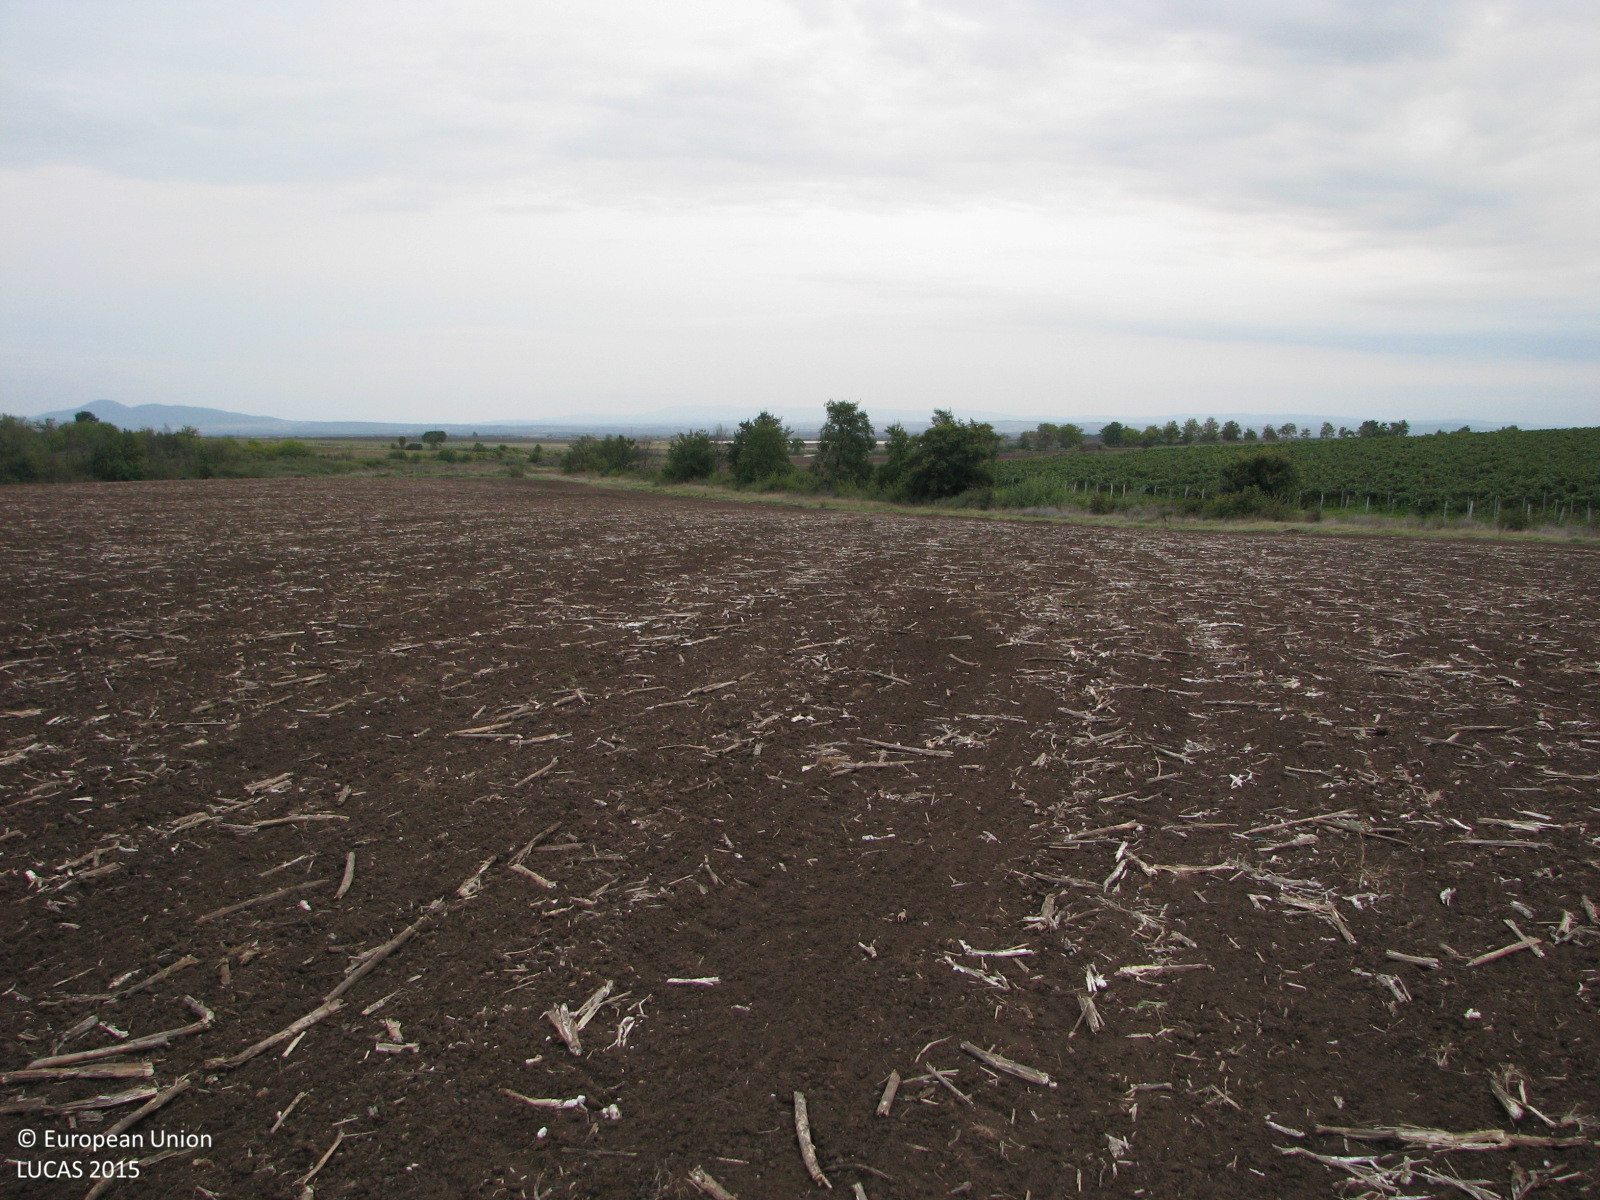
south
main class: Cropland
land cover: Sunflower
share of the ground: < 10 %
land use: Agriculture (excluding fallow land and kitchen gardens)
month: October
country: BG
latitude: 42.3909
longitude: 26.1788
